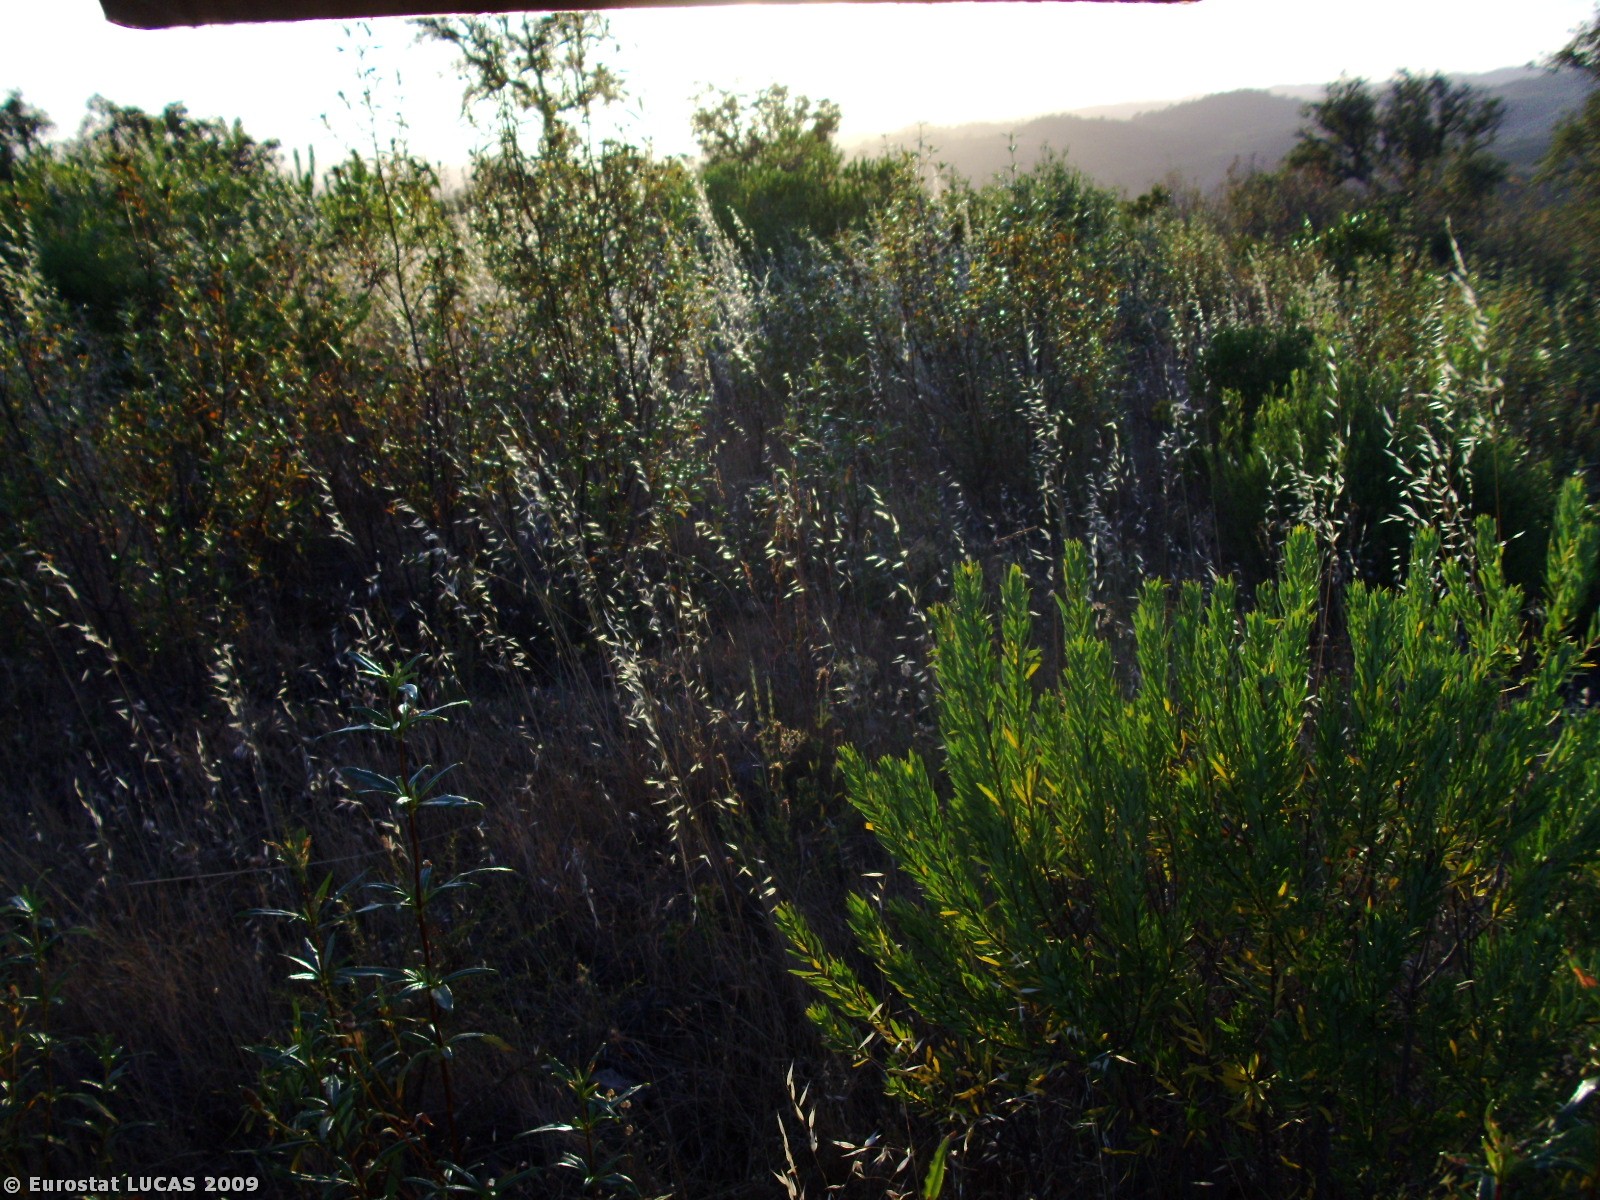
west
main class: Shrubland
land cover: Shrubland with sparse tree cover
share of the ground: > 75 %
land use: Unused
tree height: > 5 m
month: June
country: PT
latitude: 37.3582
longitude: -8.3265
